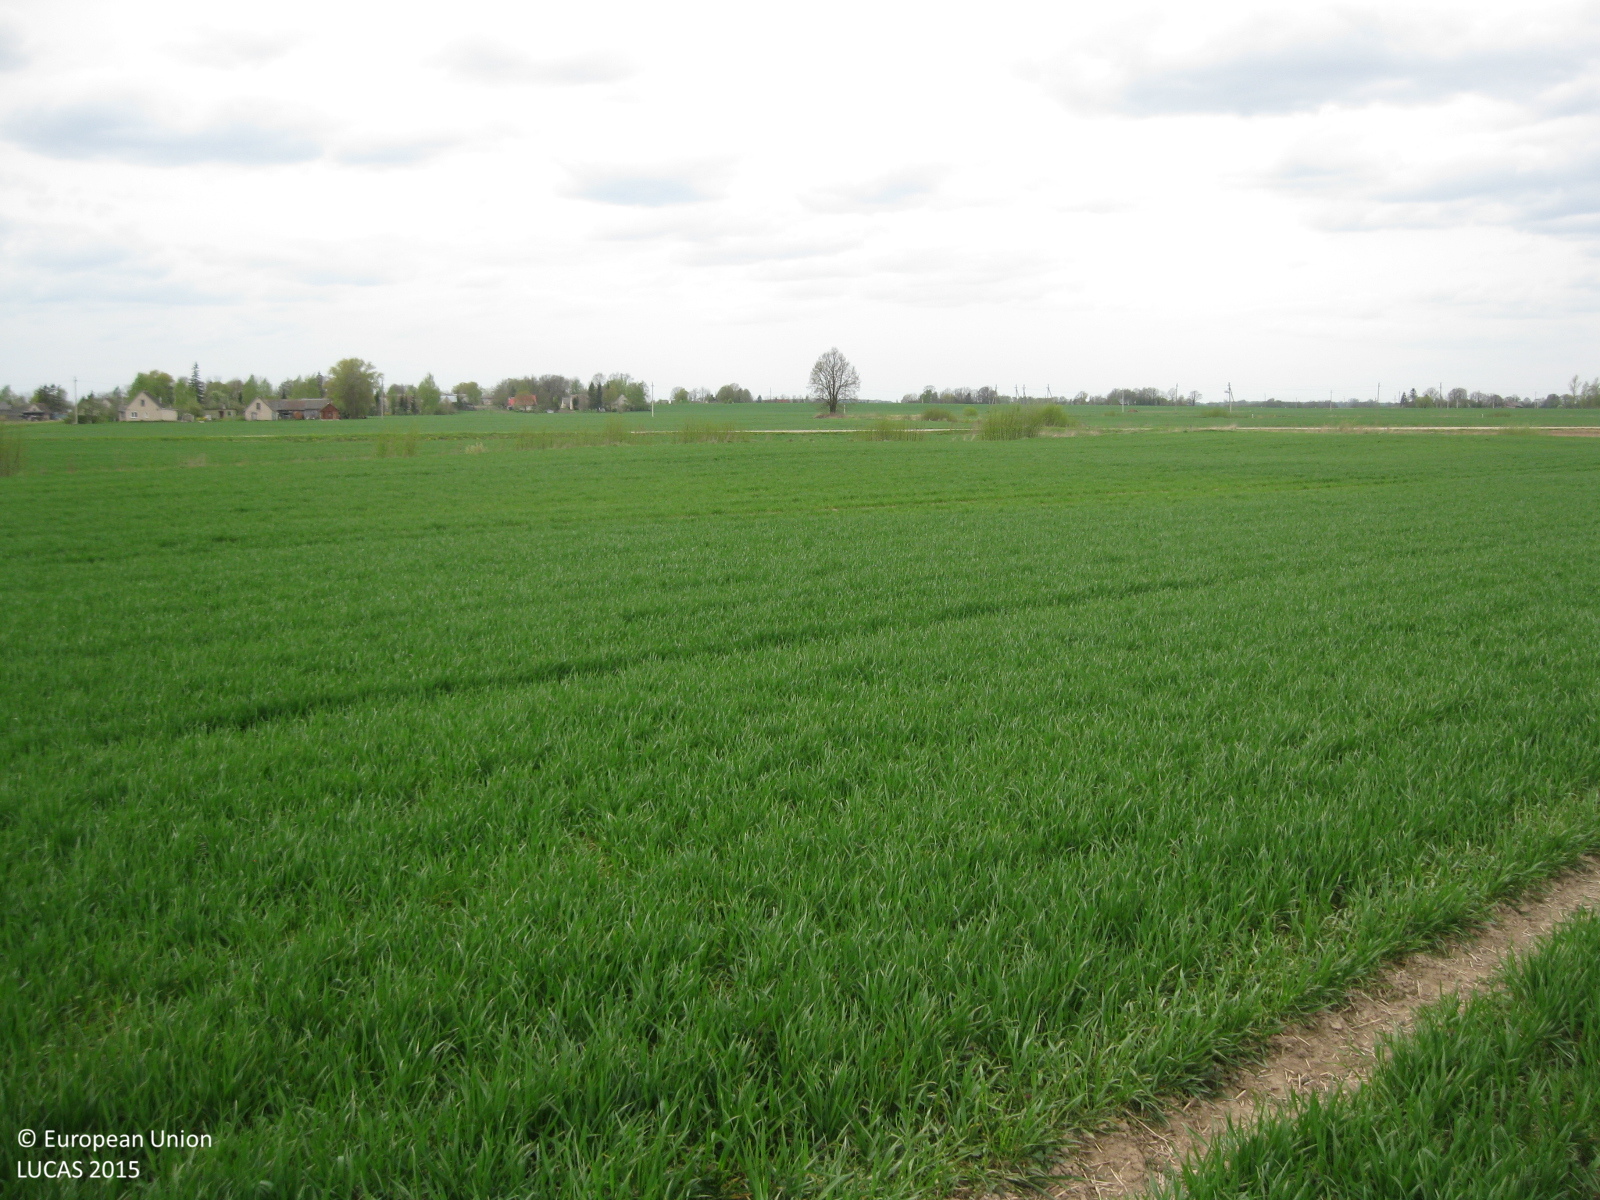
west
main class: Cropland
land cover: Common wheat
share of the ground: > 75 %
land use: Agriculture (excluding fallow land and kitchen gardens)
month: May
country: LT
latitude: 56.1870
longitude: 24.4527
